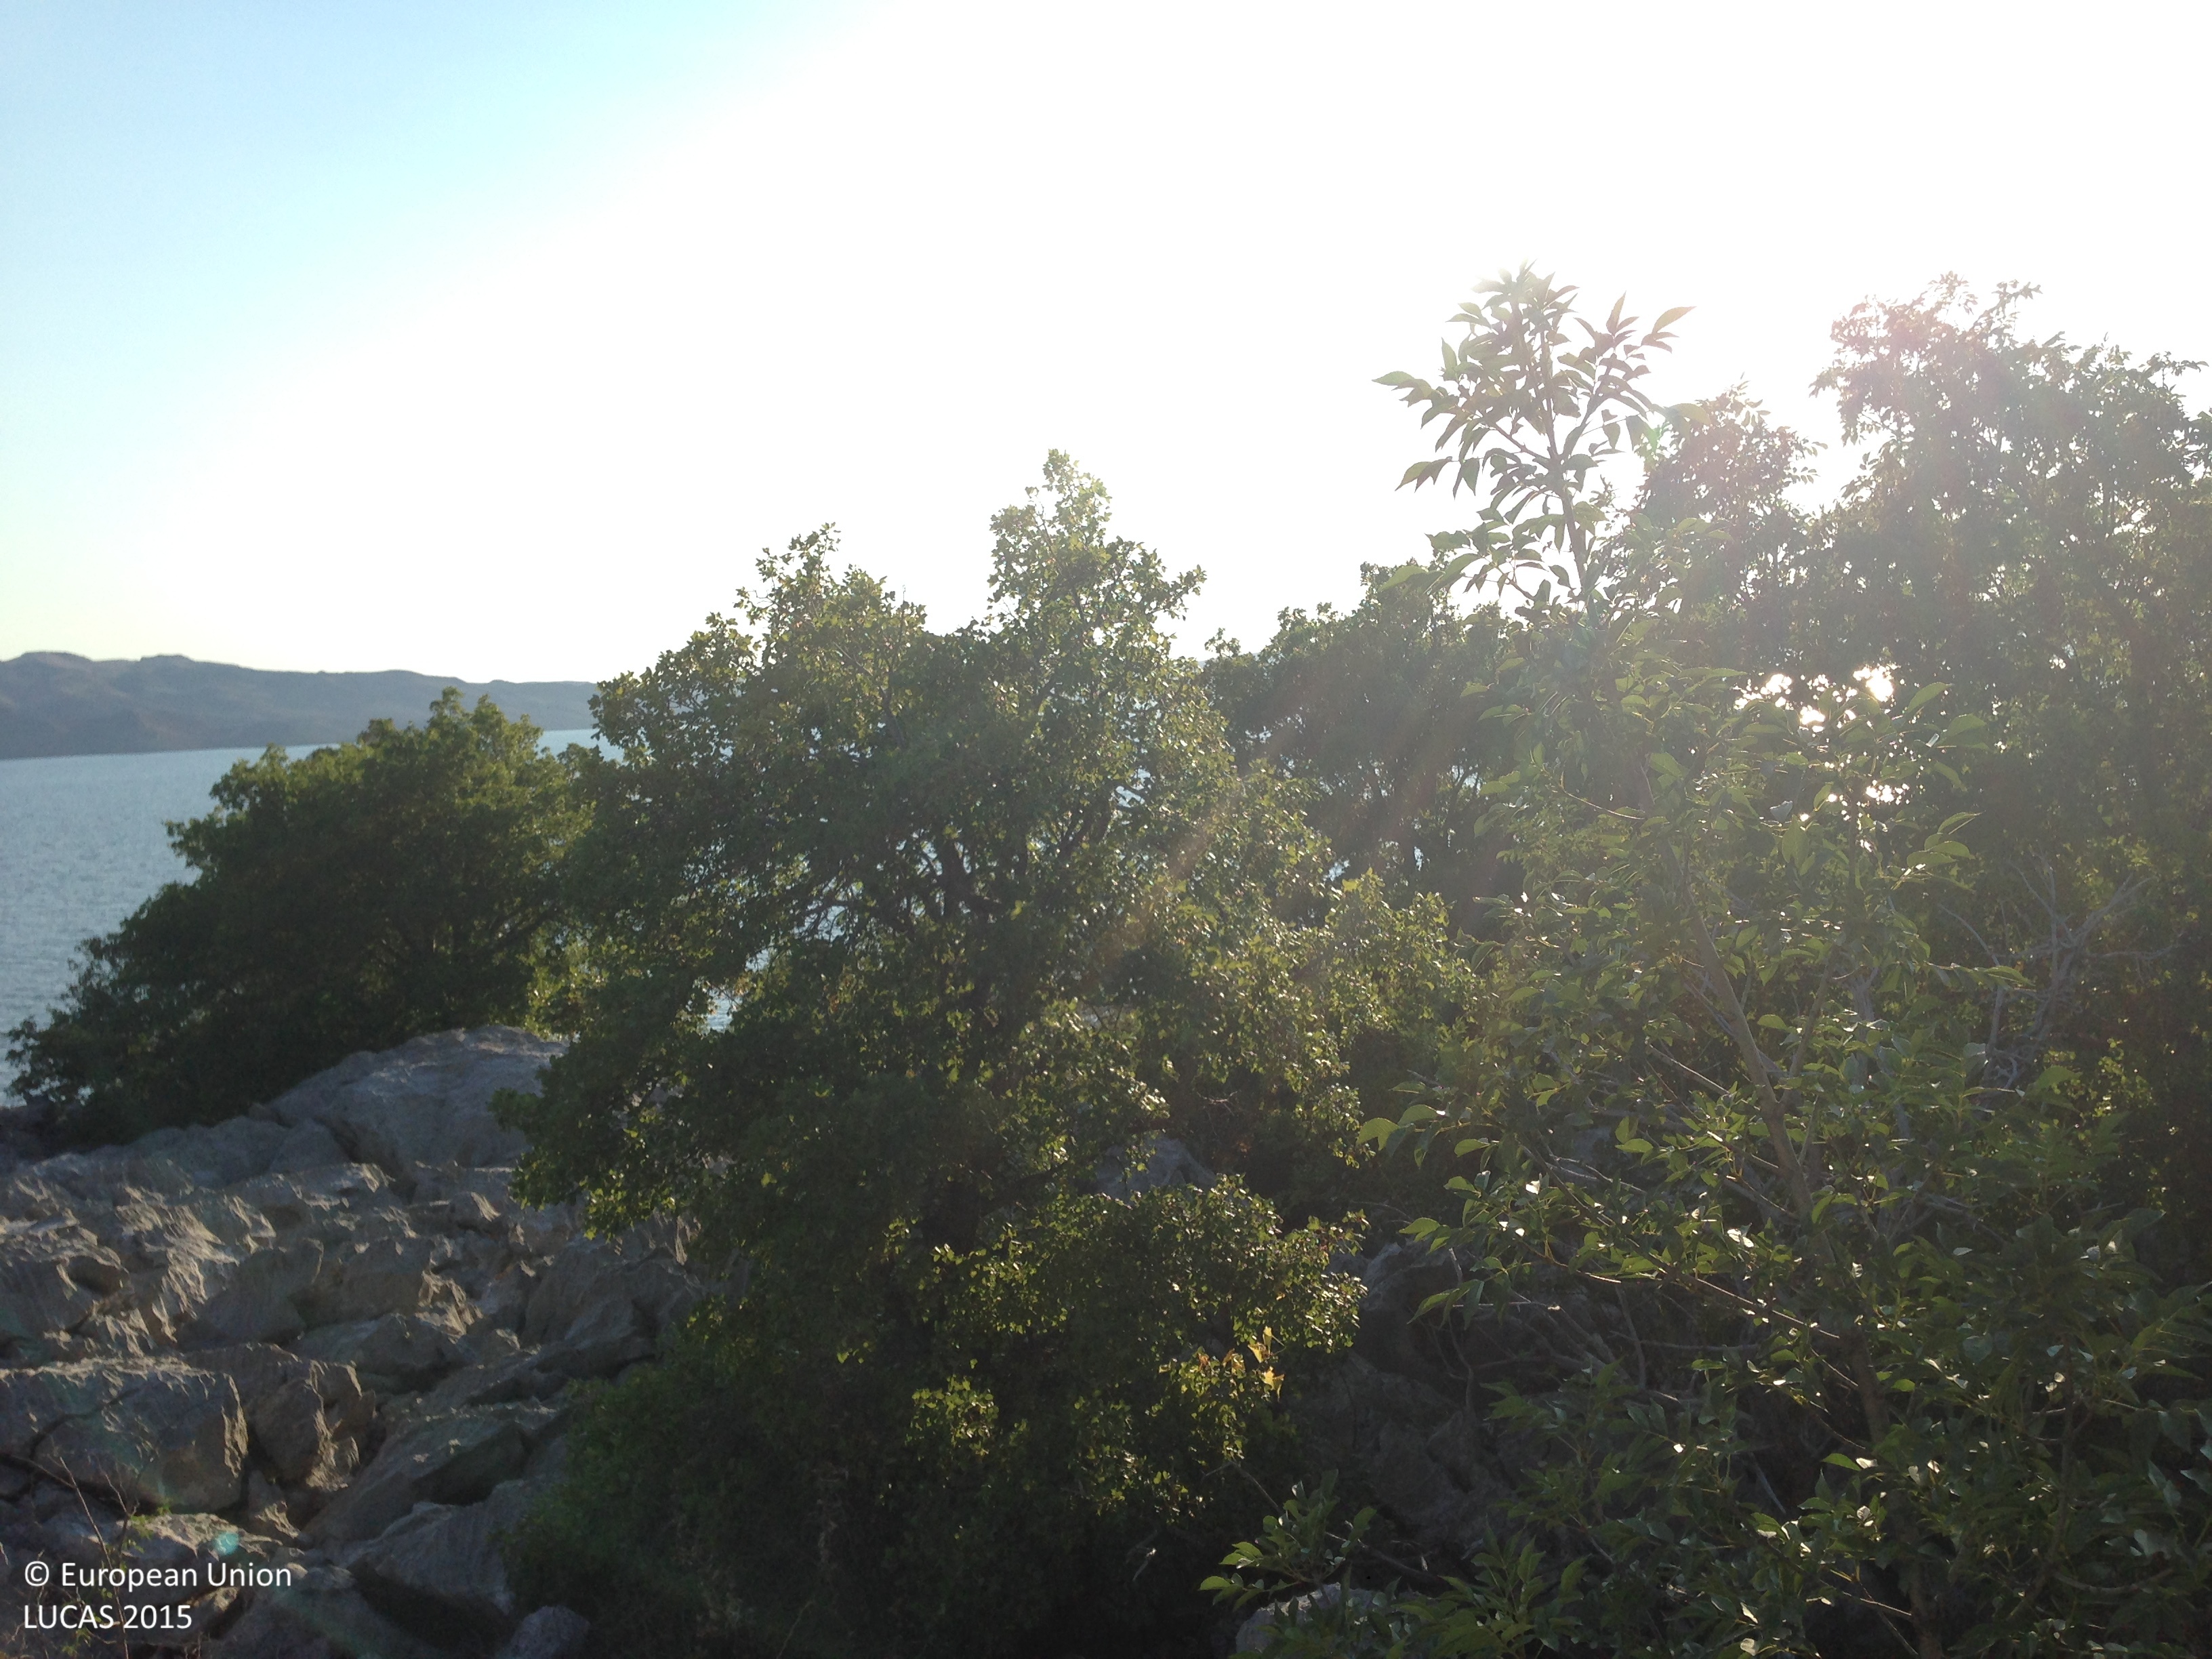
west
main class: Woodland
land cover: Broadleaved woodland
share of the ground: 25 - 50 %
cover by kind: unconsolidated bare surface 45 %, broadleaved forest trees 25 %, shrubs 10 %, herbaceous plants 10 %, consolidated bare surface 10 %
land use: Semi-natural and natural areas not in use
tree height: < 5 m
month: July
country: HR
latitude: 44.5341
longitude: 15.0646
